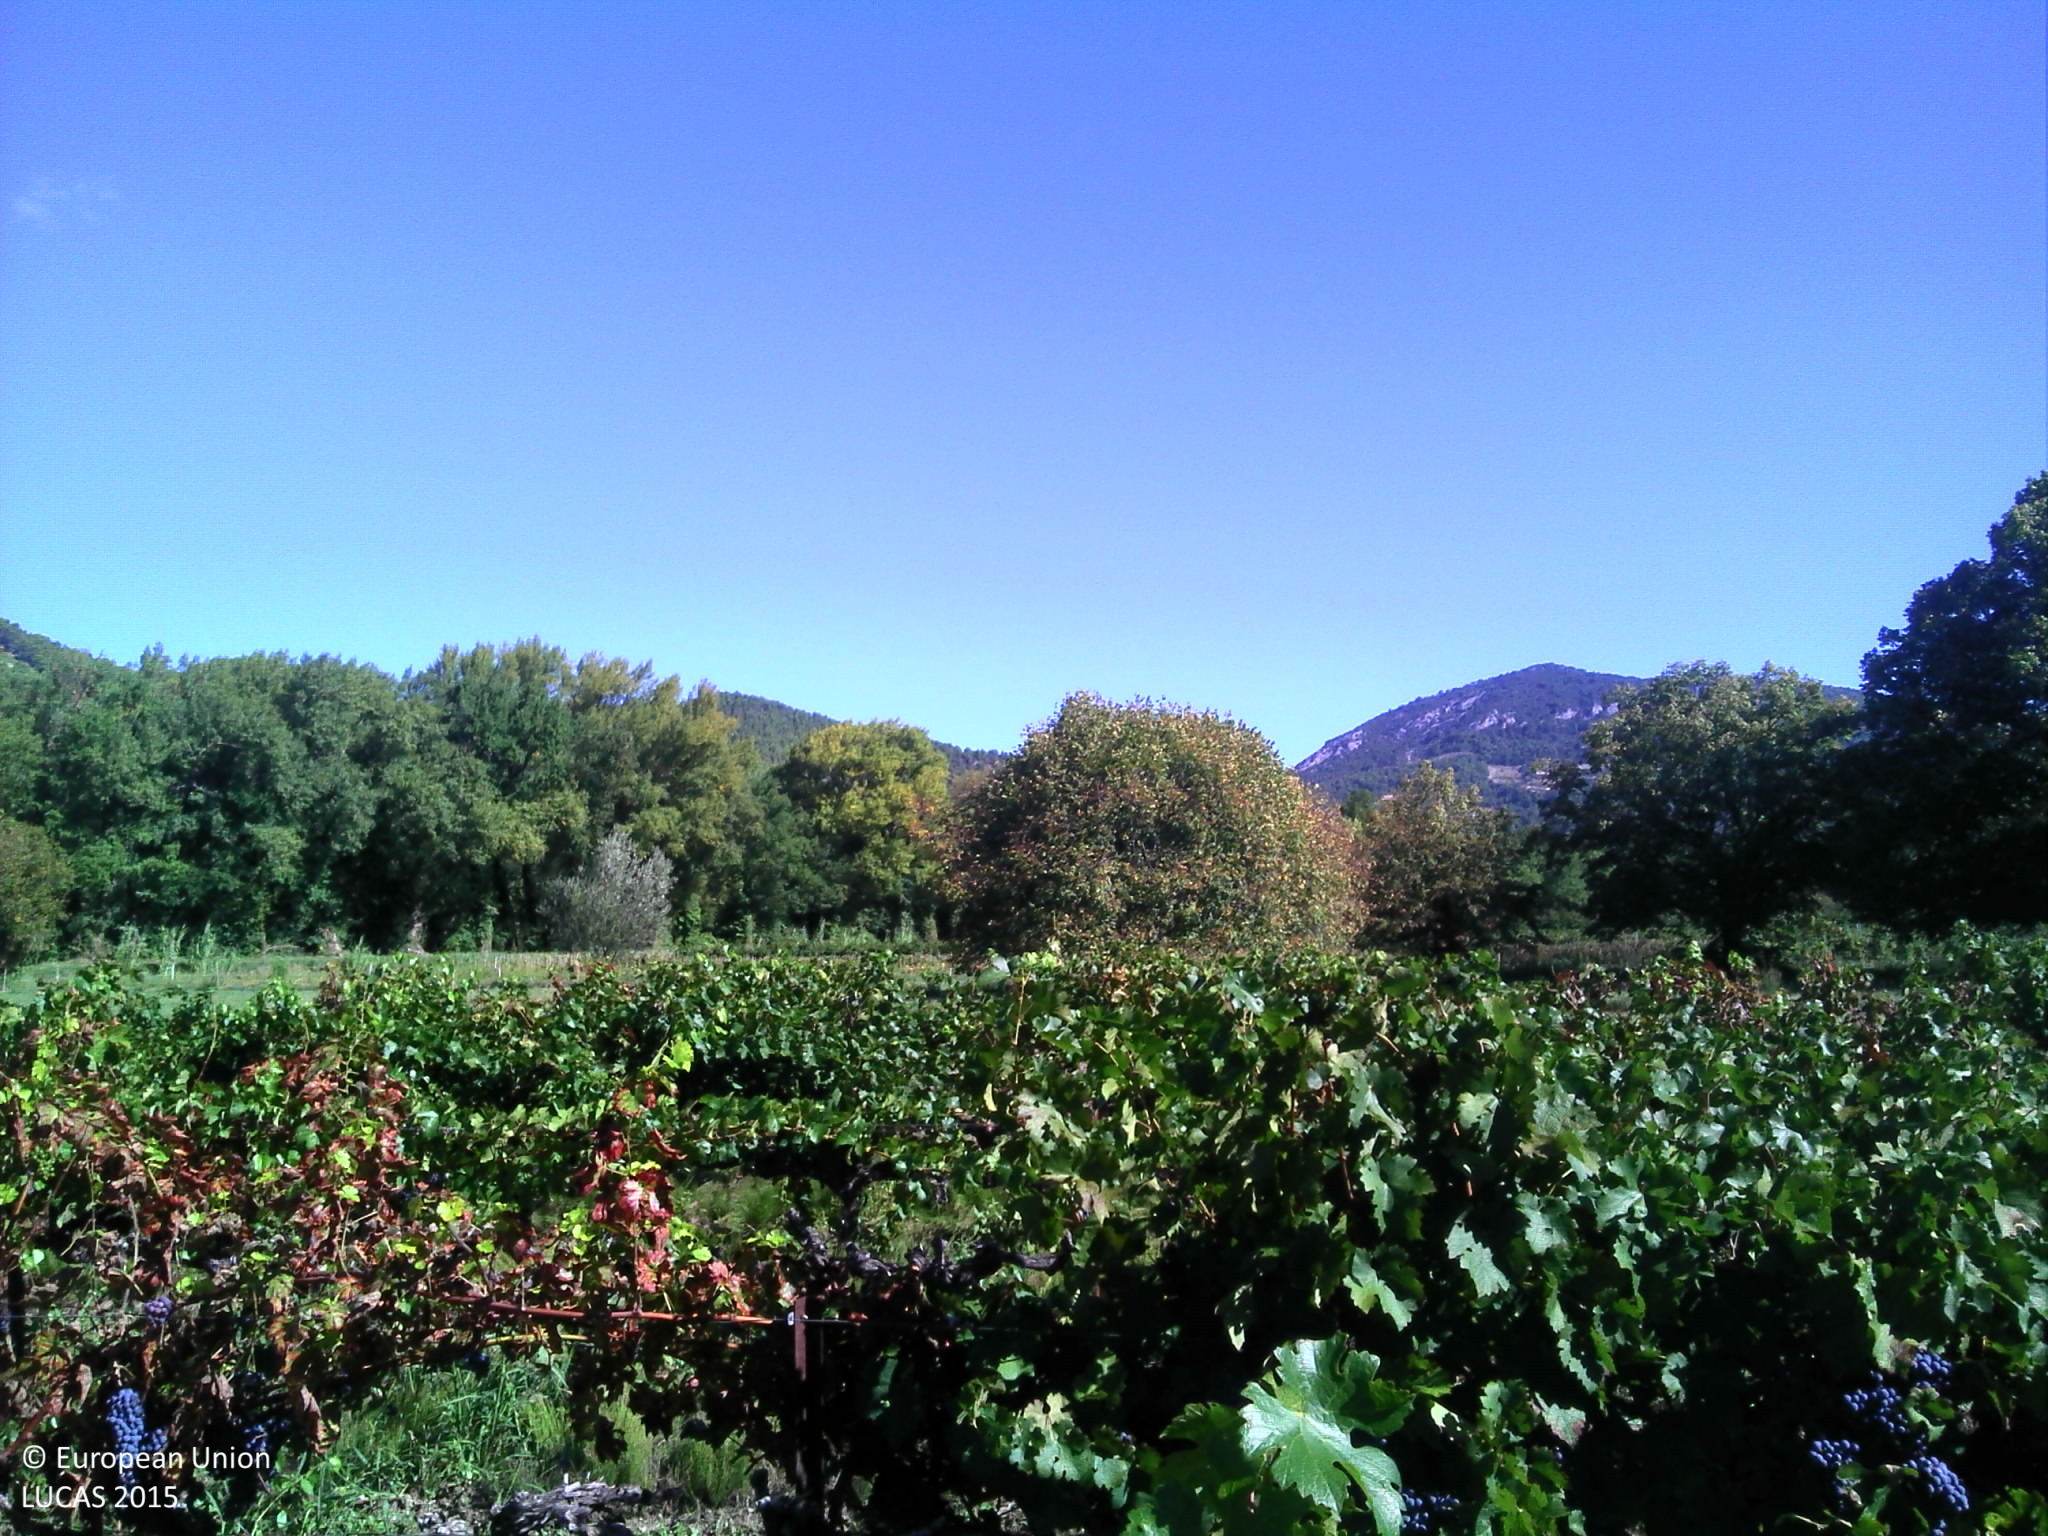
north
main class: Cropland
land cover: Vineyards
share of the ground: 50 - 75 %
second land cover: Spontaneously vegetated surfaces
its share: 10 - 25 %
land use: Agriculture (excluding fallow land and kitchen gardens)
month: September
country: FR
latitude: 44.2401
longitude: 5.2120
